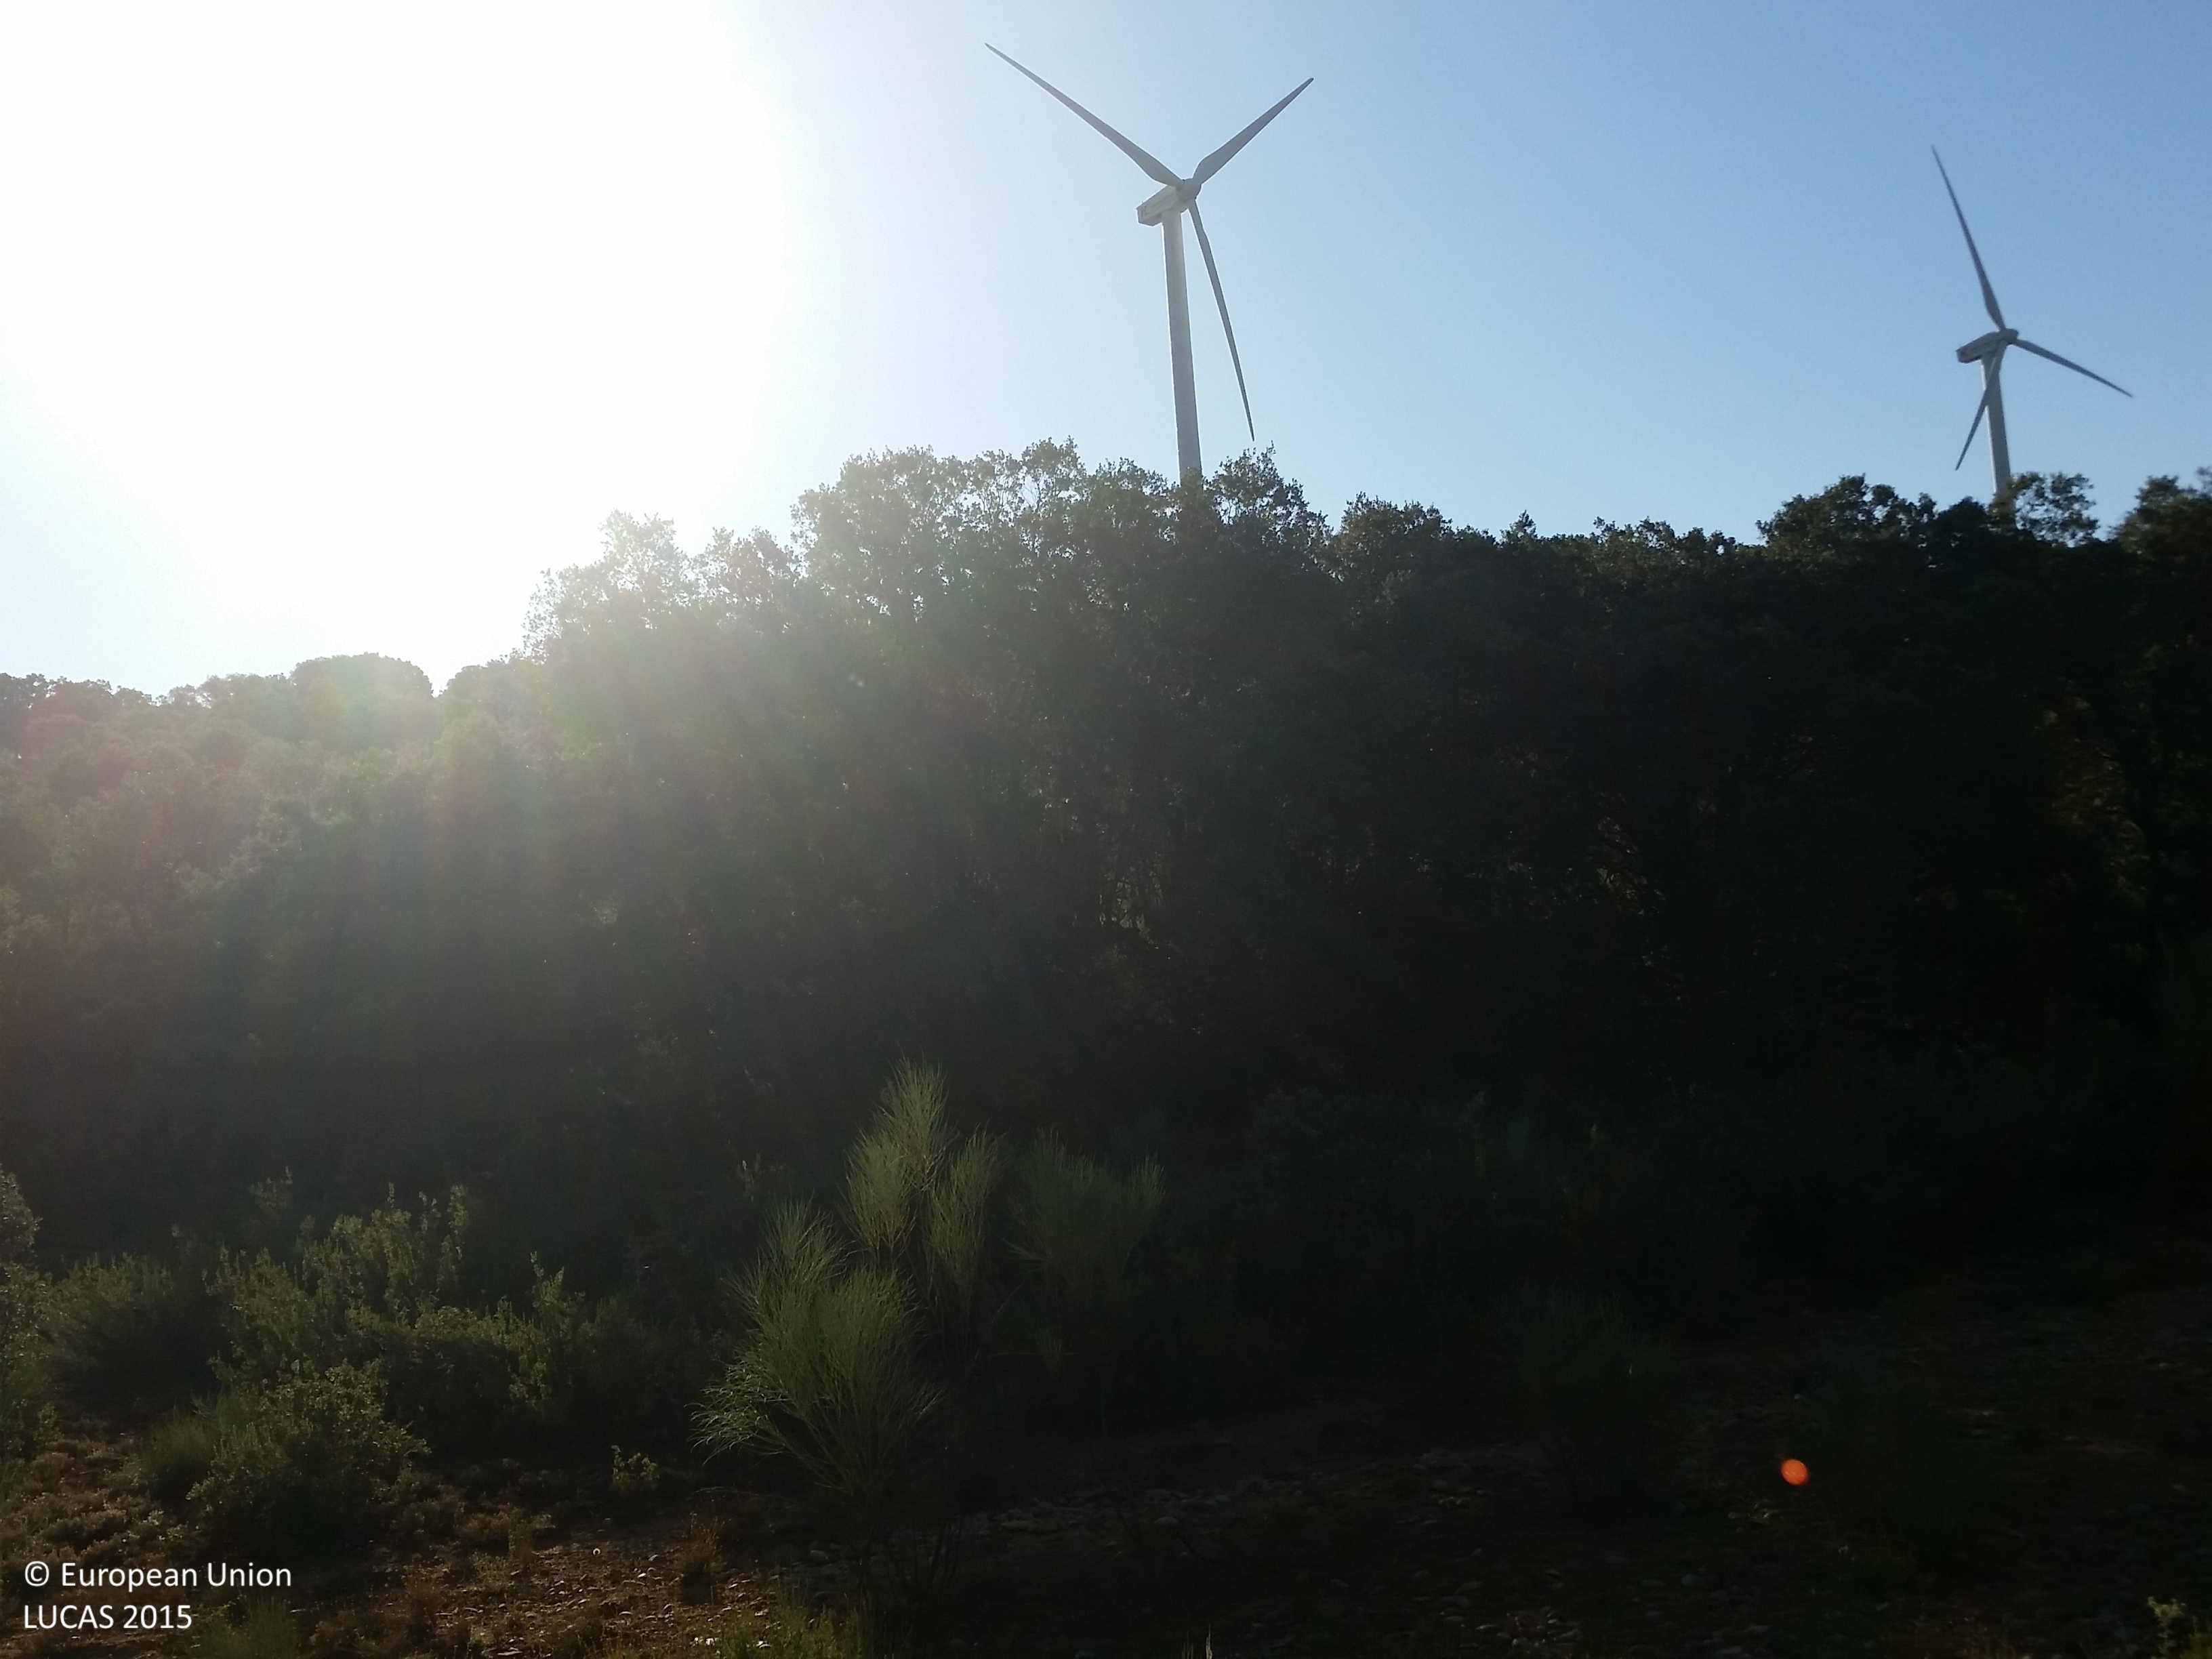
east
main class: Woodland
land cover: Broadleaved woodland
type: broadleaved evergreen forest
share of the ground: 25 - 50 %
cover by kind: broadleaved forest trees 40 %, shrubs 30 %, consolidated bare surface 20 %, herbaceous plants 10 %
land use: Semi-natural and natural areas not in use
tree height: < 5 m
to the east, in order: Broadleaved woodland; Tracks; Broadleaved woodland
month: July
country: ES
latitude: 38.9729
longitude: -2.4823
